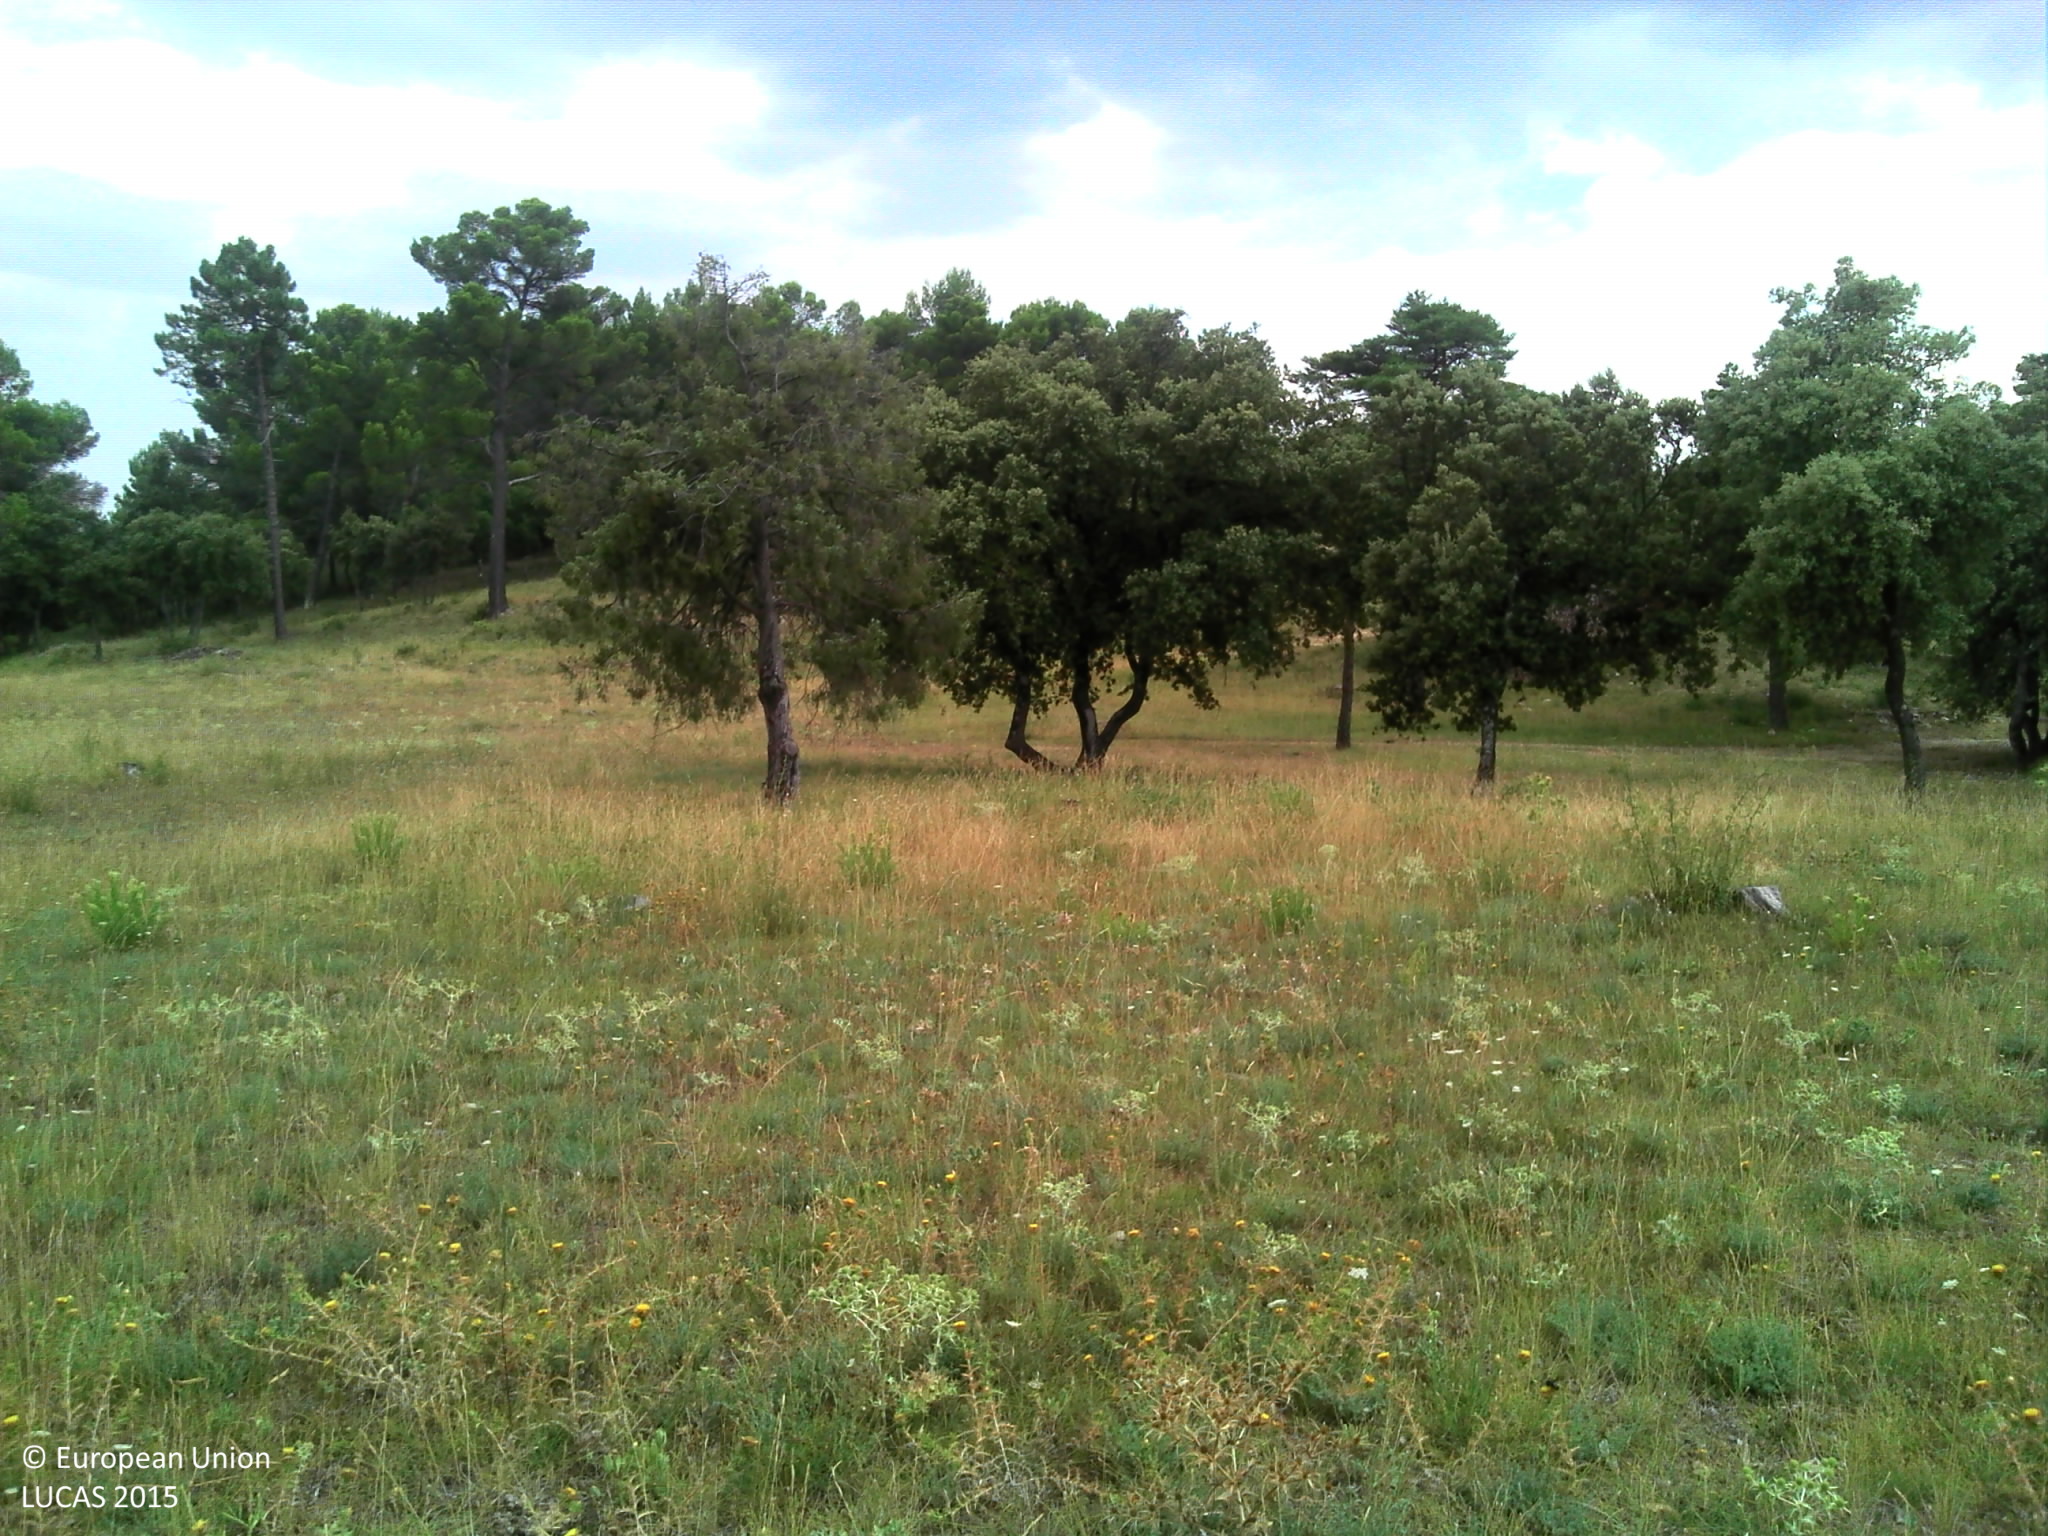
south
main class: Grassland
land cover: Grassland with sparse tree/shrub cover
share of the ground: > 75 %
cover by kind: herbaceous plants 95 %, coniferous forest trees 5 %
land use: Amenities, museums, leisure
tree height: > 5 m
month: August
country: FR
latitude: 43.5814
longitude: 6.3305
